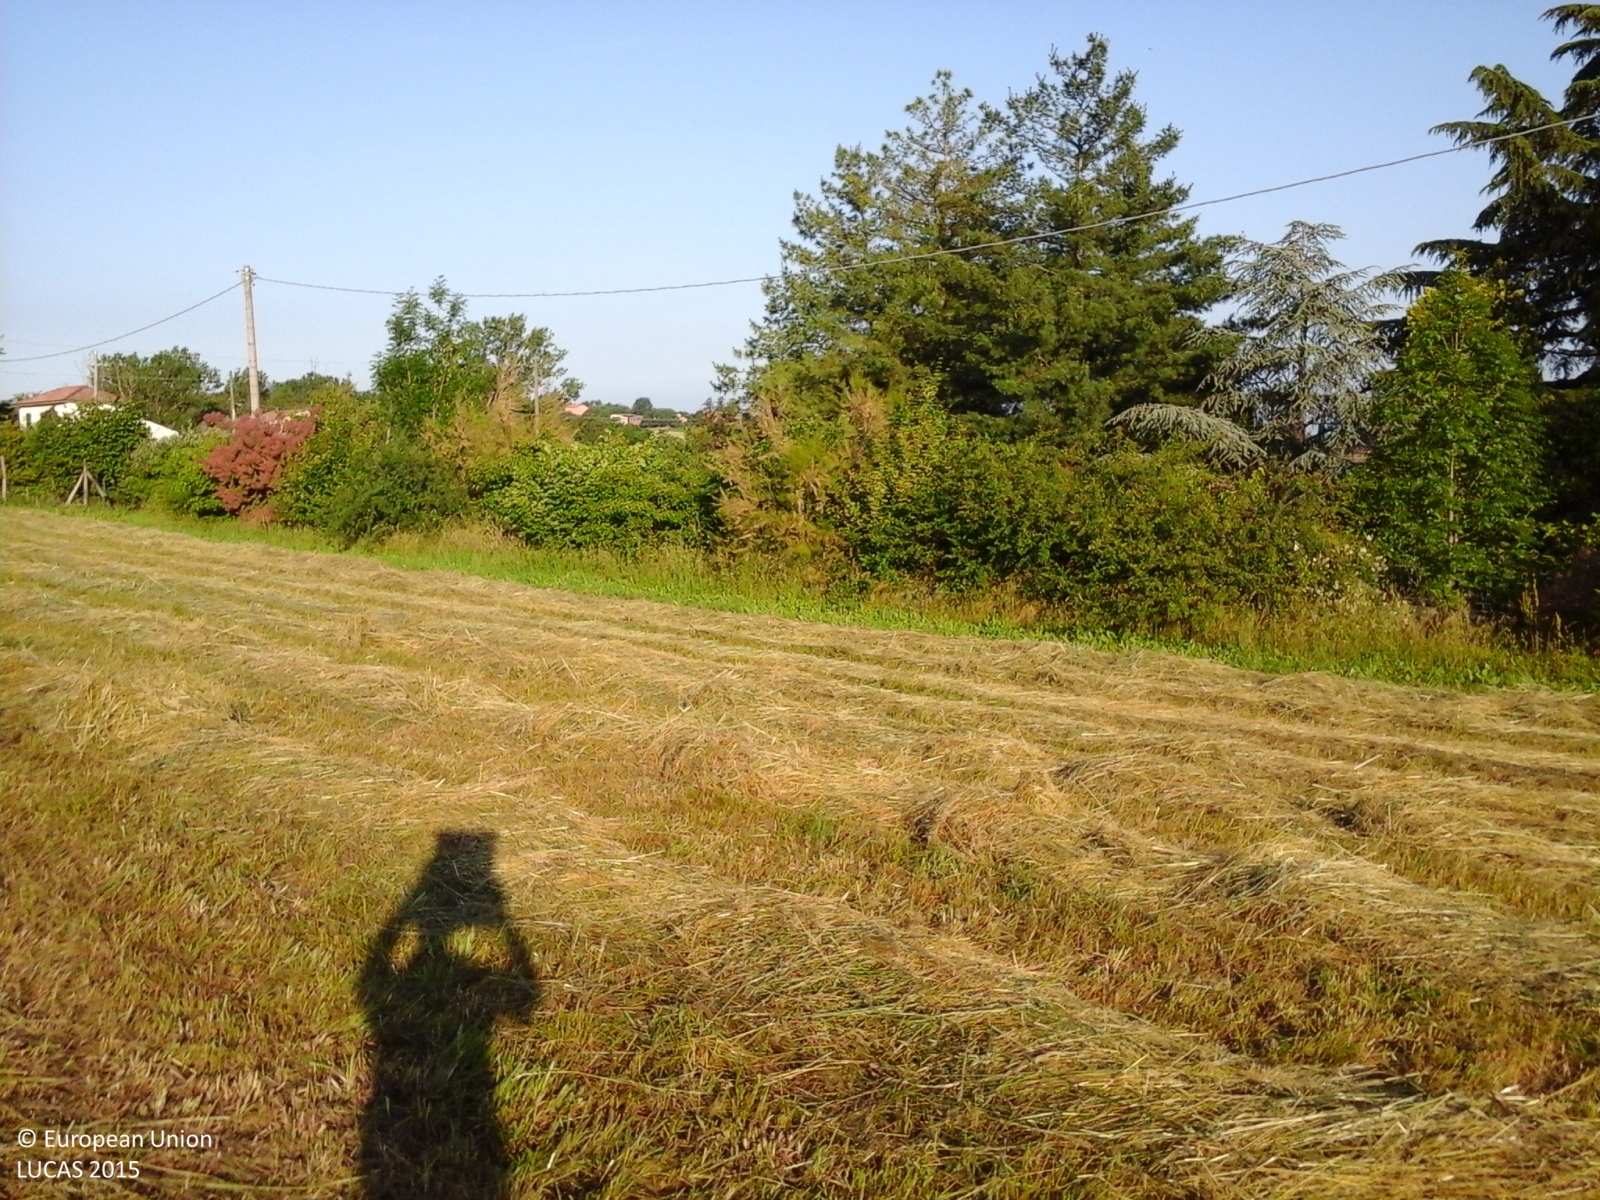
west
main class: Grassland
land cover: Grassland without tree/shrub cover
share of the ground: > 75 %
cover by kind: herbaceous plants 100 %
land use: Agriculture (excluding fallow land and kitchen gardens)
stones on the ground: < 10 %
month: May
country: IT
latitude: 44.8014
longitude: 10.0631
